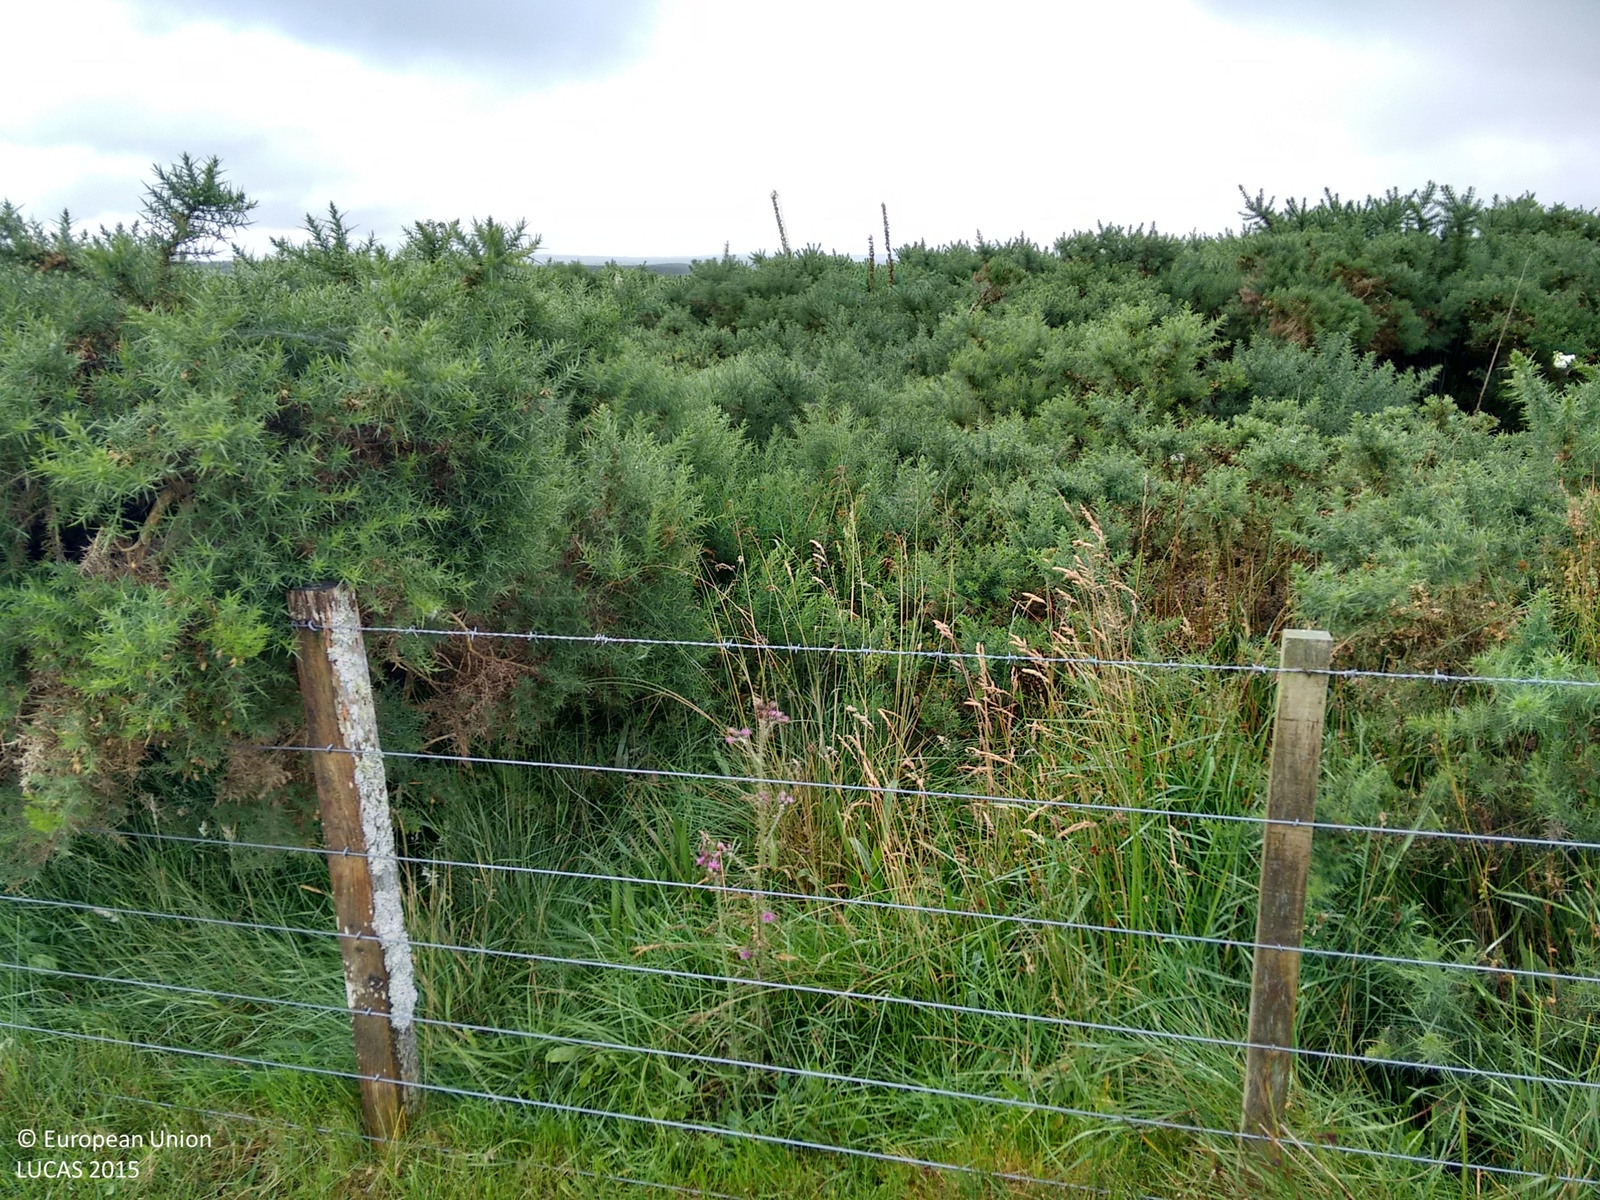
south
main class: Grassland
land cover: Grassland without tree/shrub cover
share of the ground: > 75 %
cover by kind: herbaceous plants 100 %
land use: Agriculture (excluding fallow land and kitchen gardens)
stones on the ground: < 10 %
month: August
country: GB
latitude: 58.4912
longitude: -3.2522
